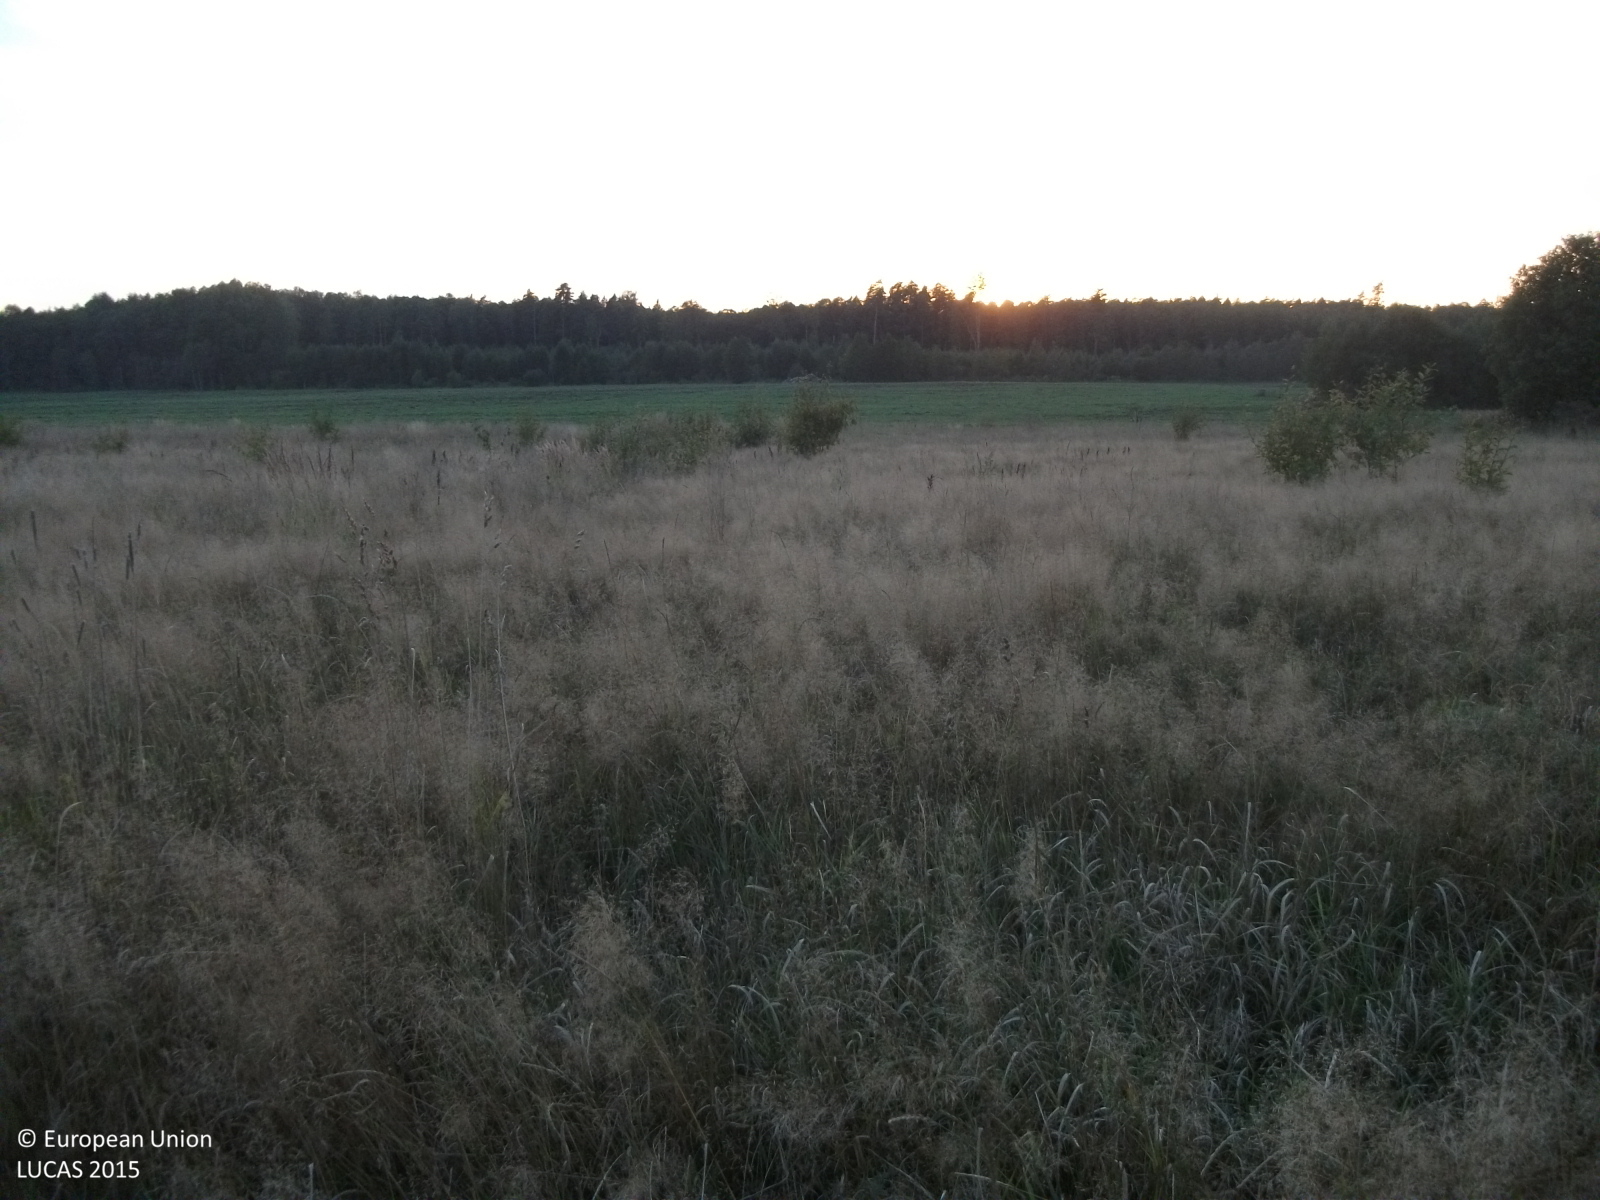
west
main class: Grassland
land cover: Grassland with sparse tree/shrub cover
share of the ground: > 75 %
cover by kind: herbaceous plants 90 %, broadleaved forest trees 5 %, shrubs 5 %
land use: Semi-natural and natural areas not in use
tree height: < 5 m
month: September
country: LV
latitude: 57.5641
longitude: 24.5859
